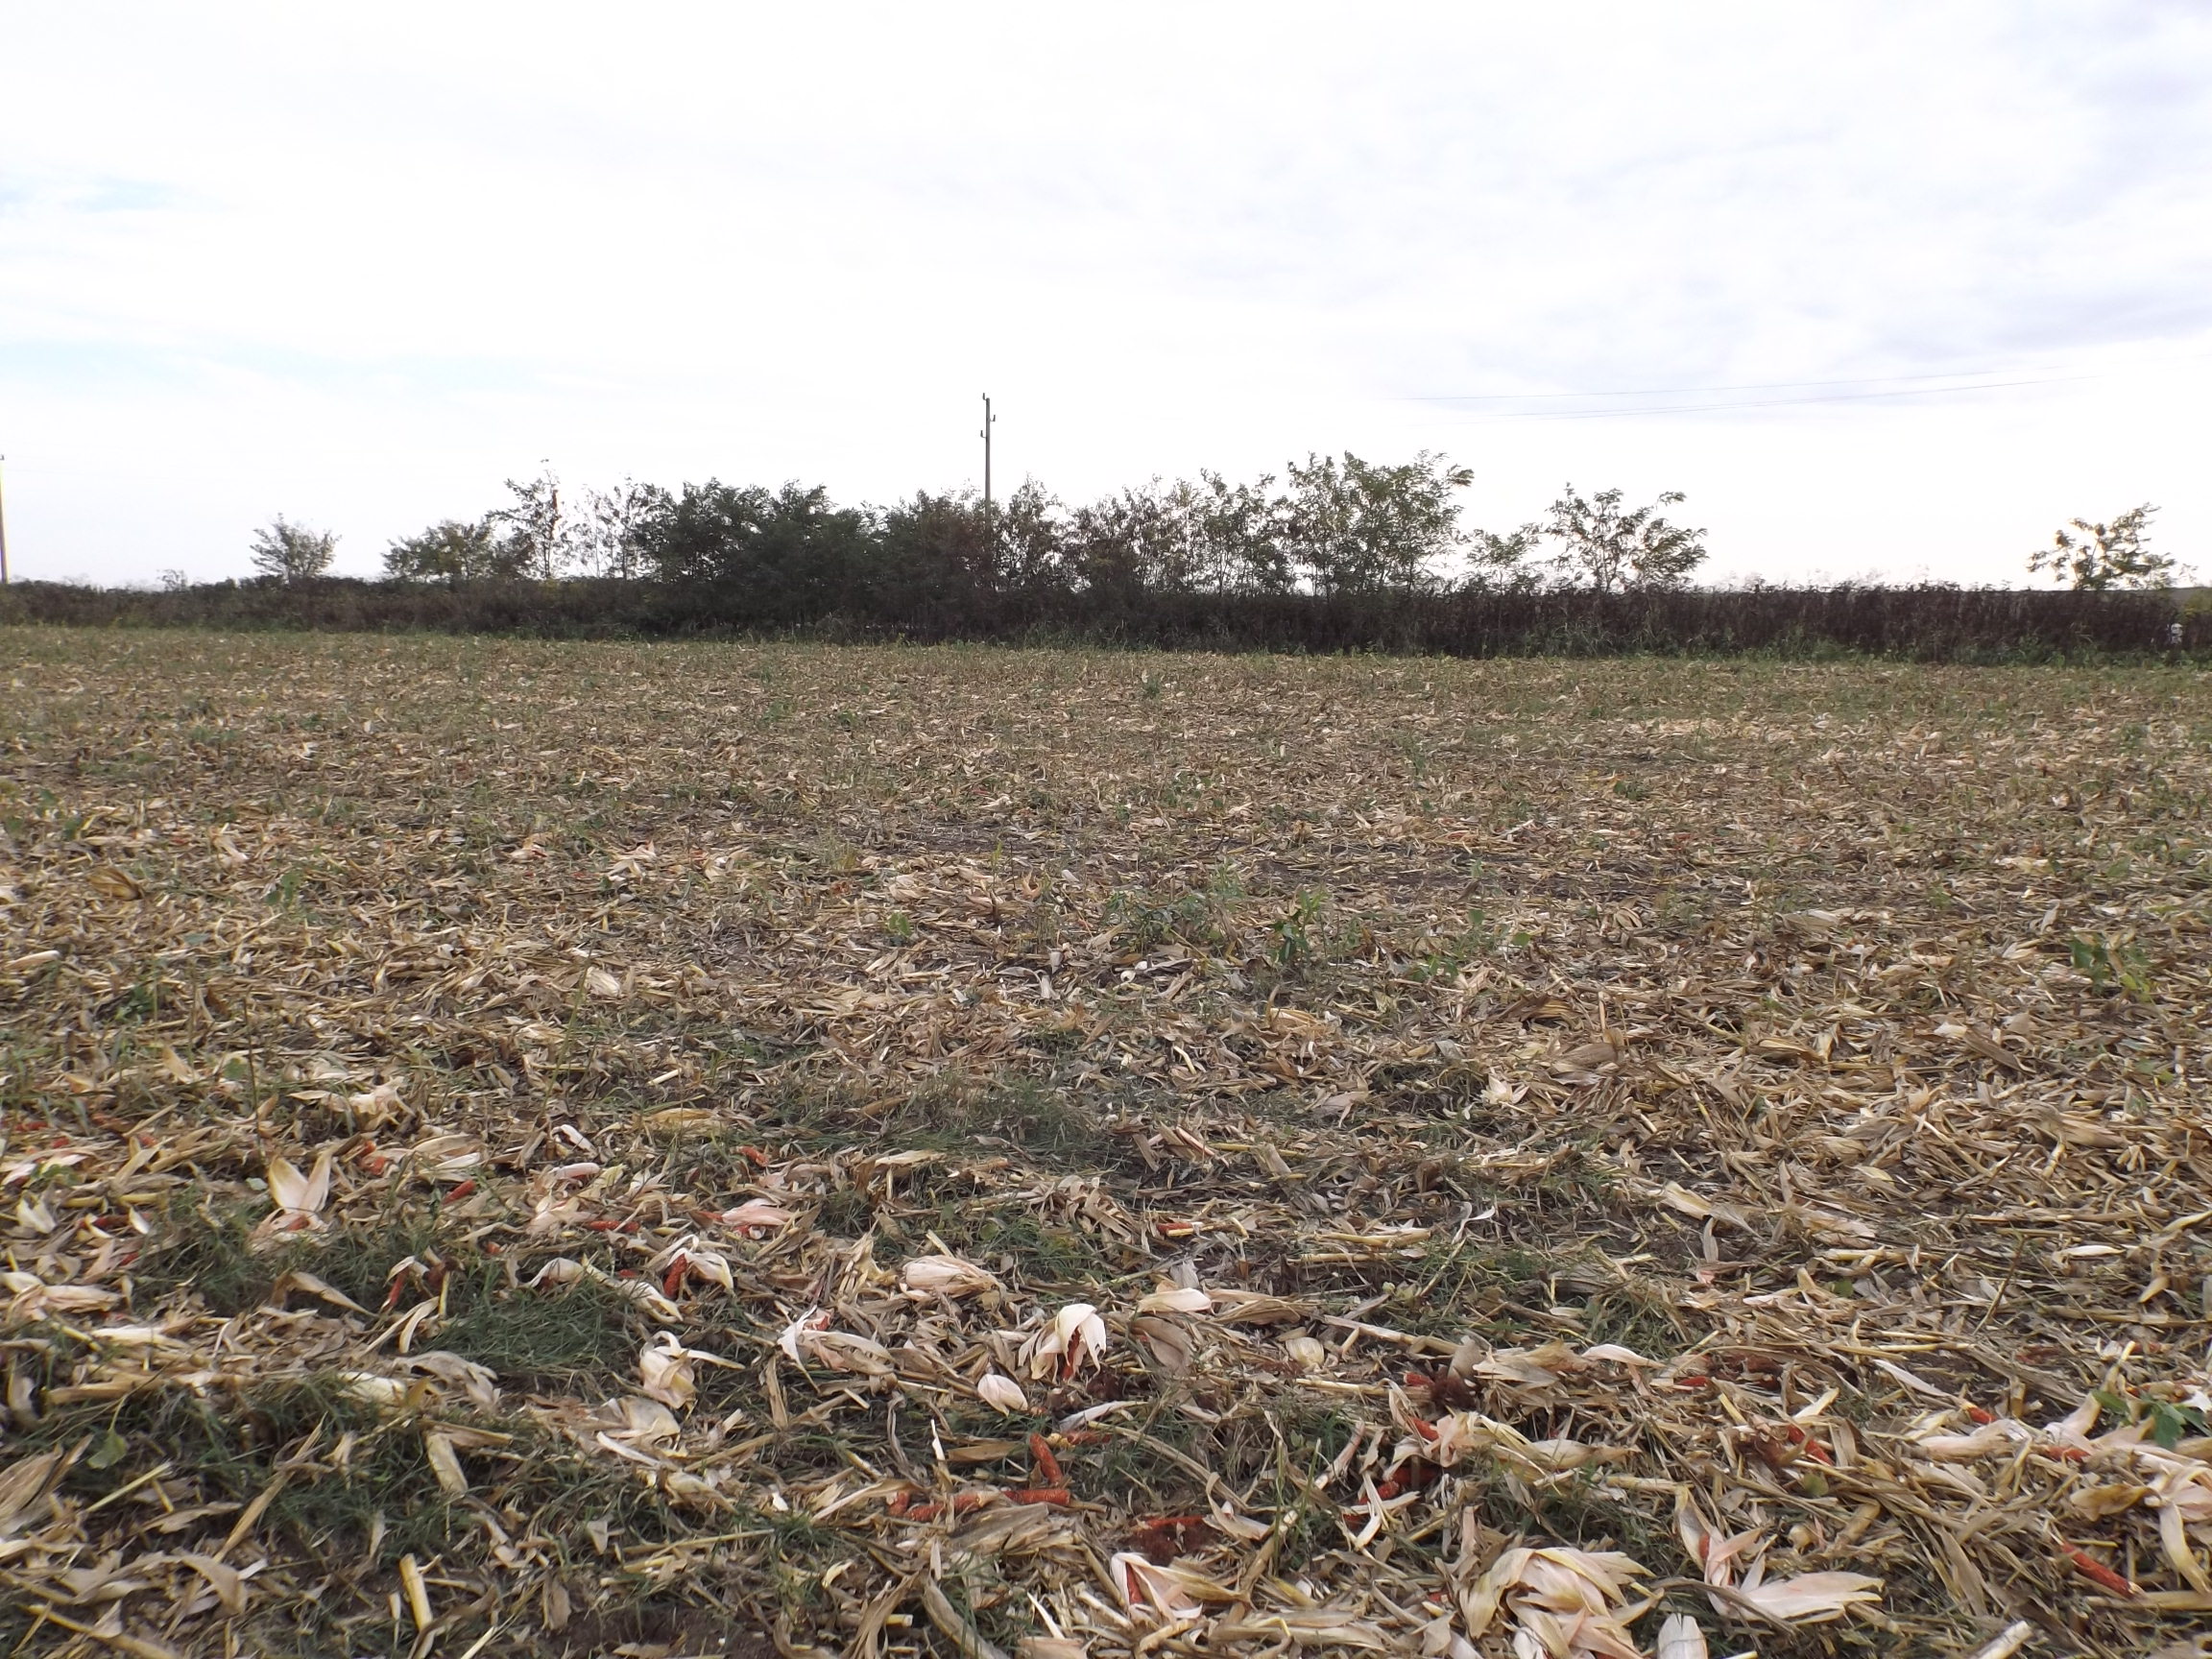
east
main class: Cropland
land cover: Maize
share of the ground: < 10 %
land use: Agriculture (excluding fallow land and kitchen gardens)
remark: Harvested field
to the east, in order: Maize; Grass margins; Managed hedges; Ditches and canals; Paved roads, cycling and walking lanes; Ditches and canals; Grass margins; Maize; Electric lines; Maize
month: October
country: BG
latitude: 43.9357
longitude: 26.8488
